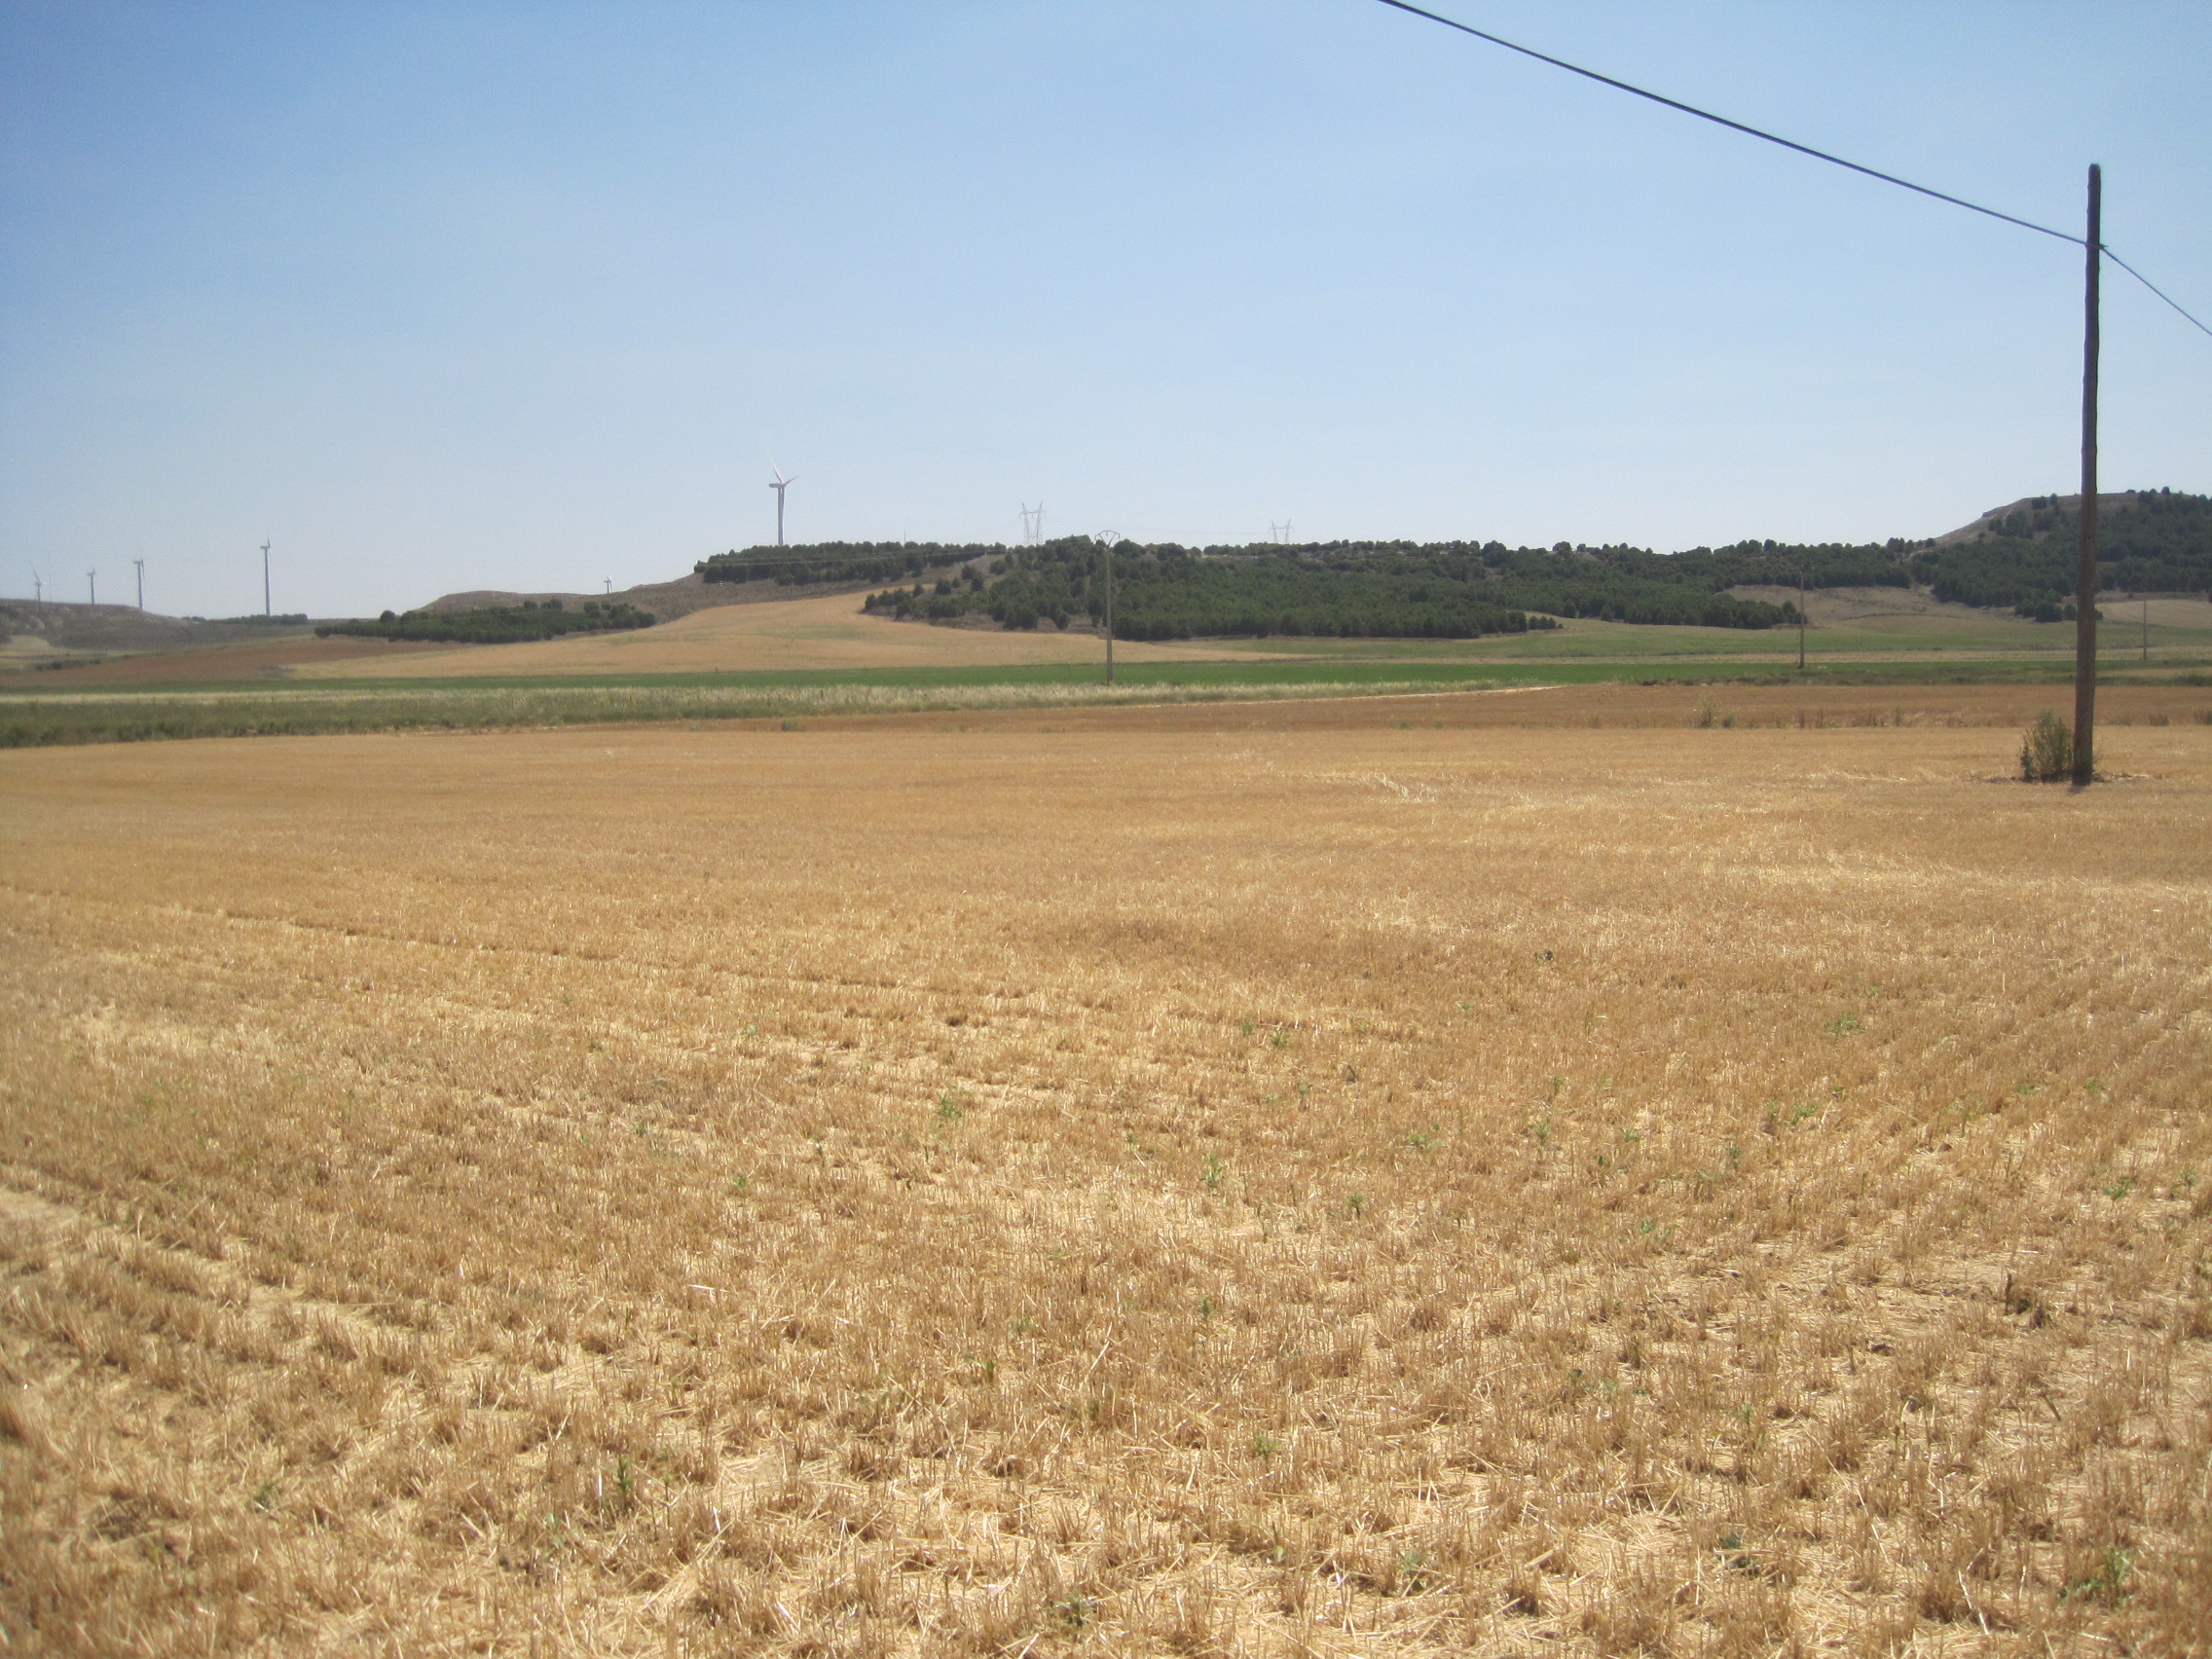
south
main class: Cropland
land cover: Barley
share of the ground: < 10 %
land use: Agriculture (excluding fallow land and kitchen gardens)
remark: Harvested field
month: July
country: ES
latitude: 41.9692
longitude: -4.7592
